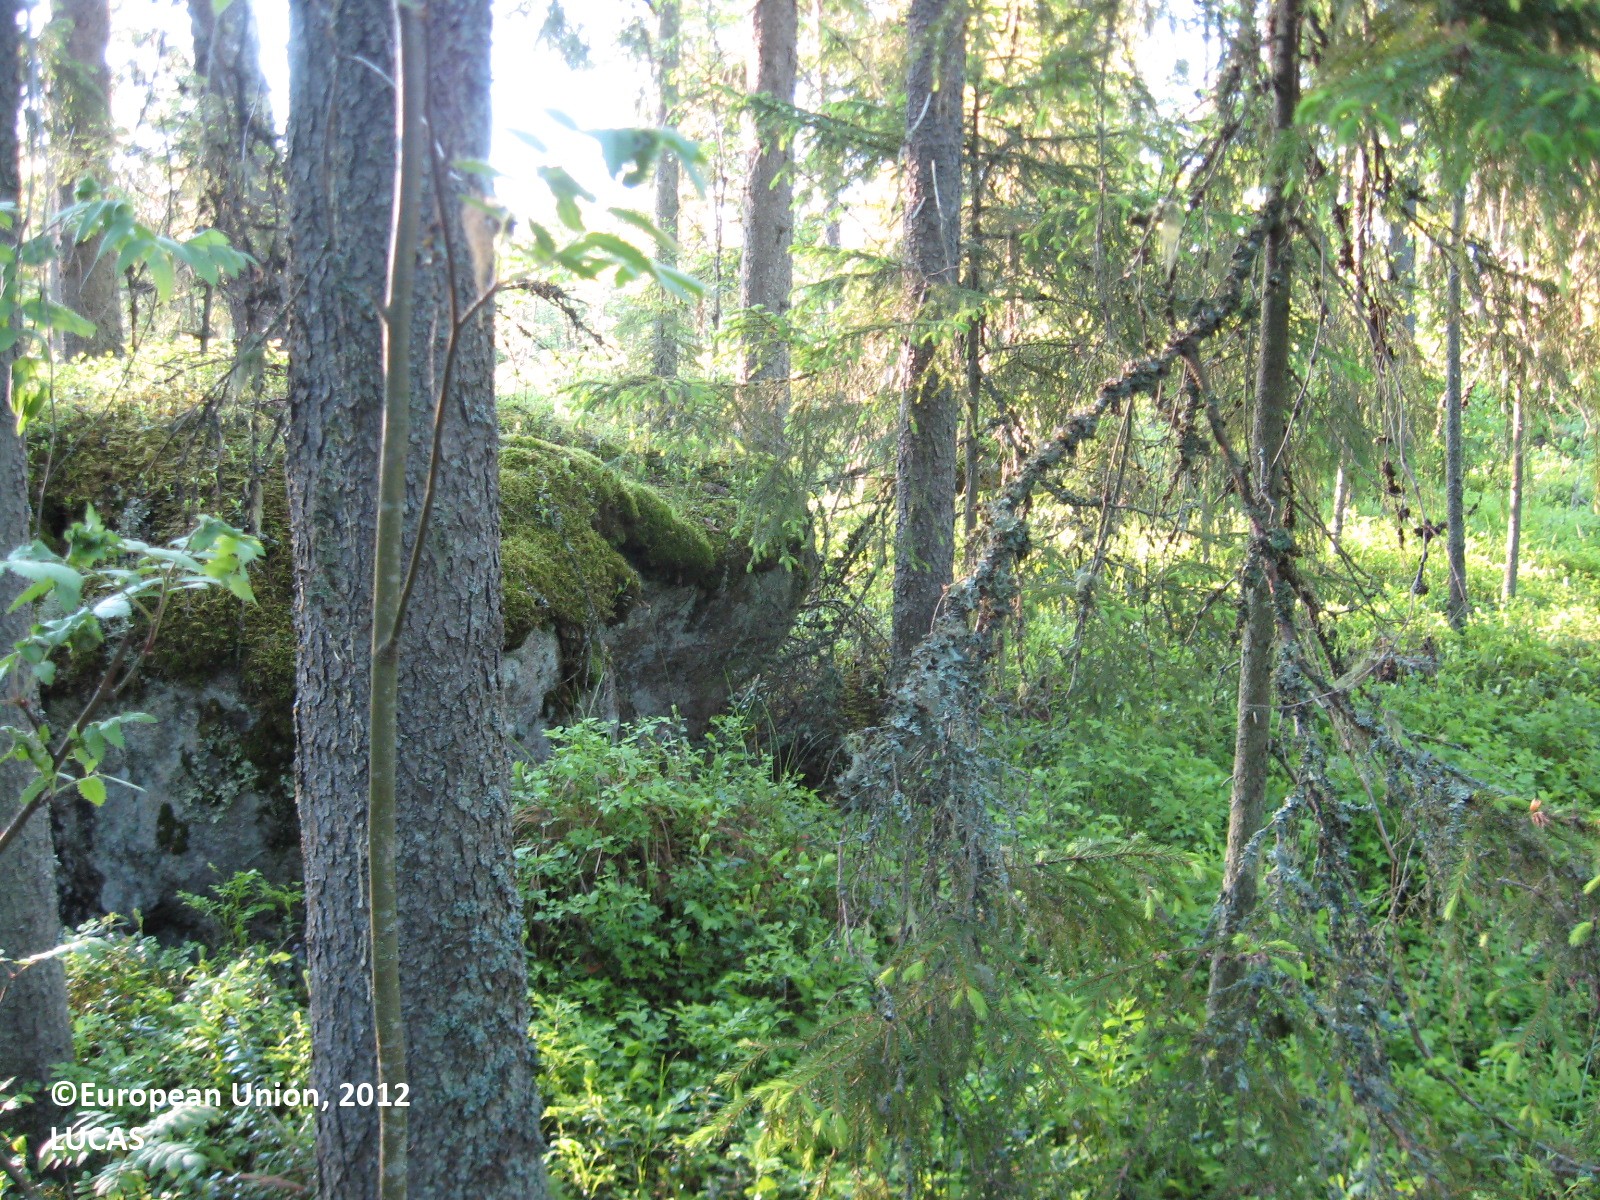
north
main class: Woodland
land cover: Spruce dominated coniferous woodland
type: boreal forest
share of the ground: > 75 %
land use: Forestry
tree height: > 5 m
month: June
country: FI
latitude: 63.1351
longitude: 22.6881
